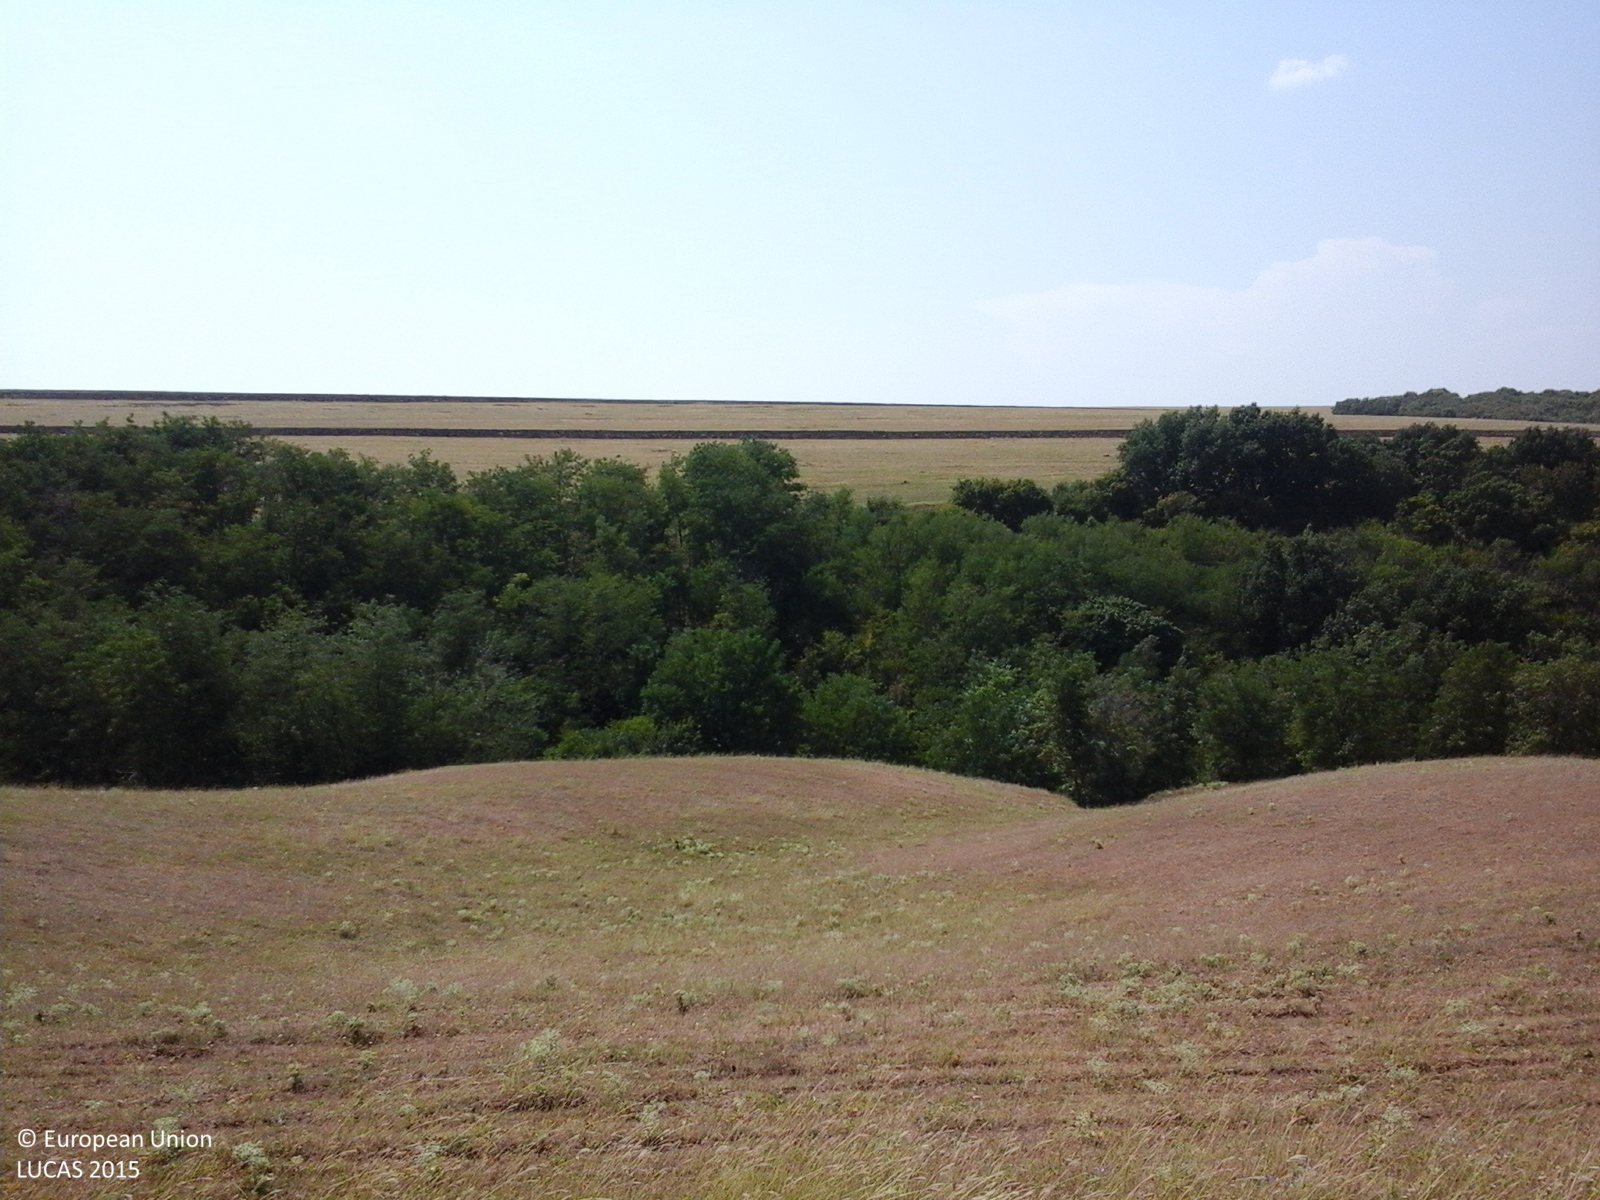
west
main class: Cropland
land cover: Sunflower
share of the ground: > 75 %
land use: Agriculture (excluding fallow land and kitchen gardens)
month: July
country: RO
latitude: 45.7001
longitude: 27.9574
